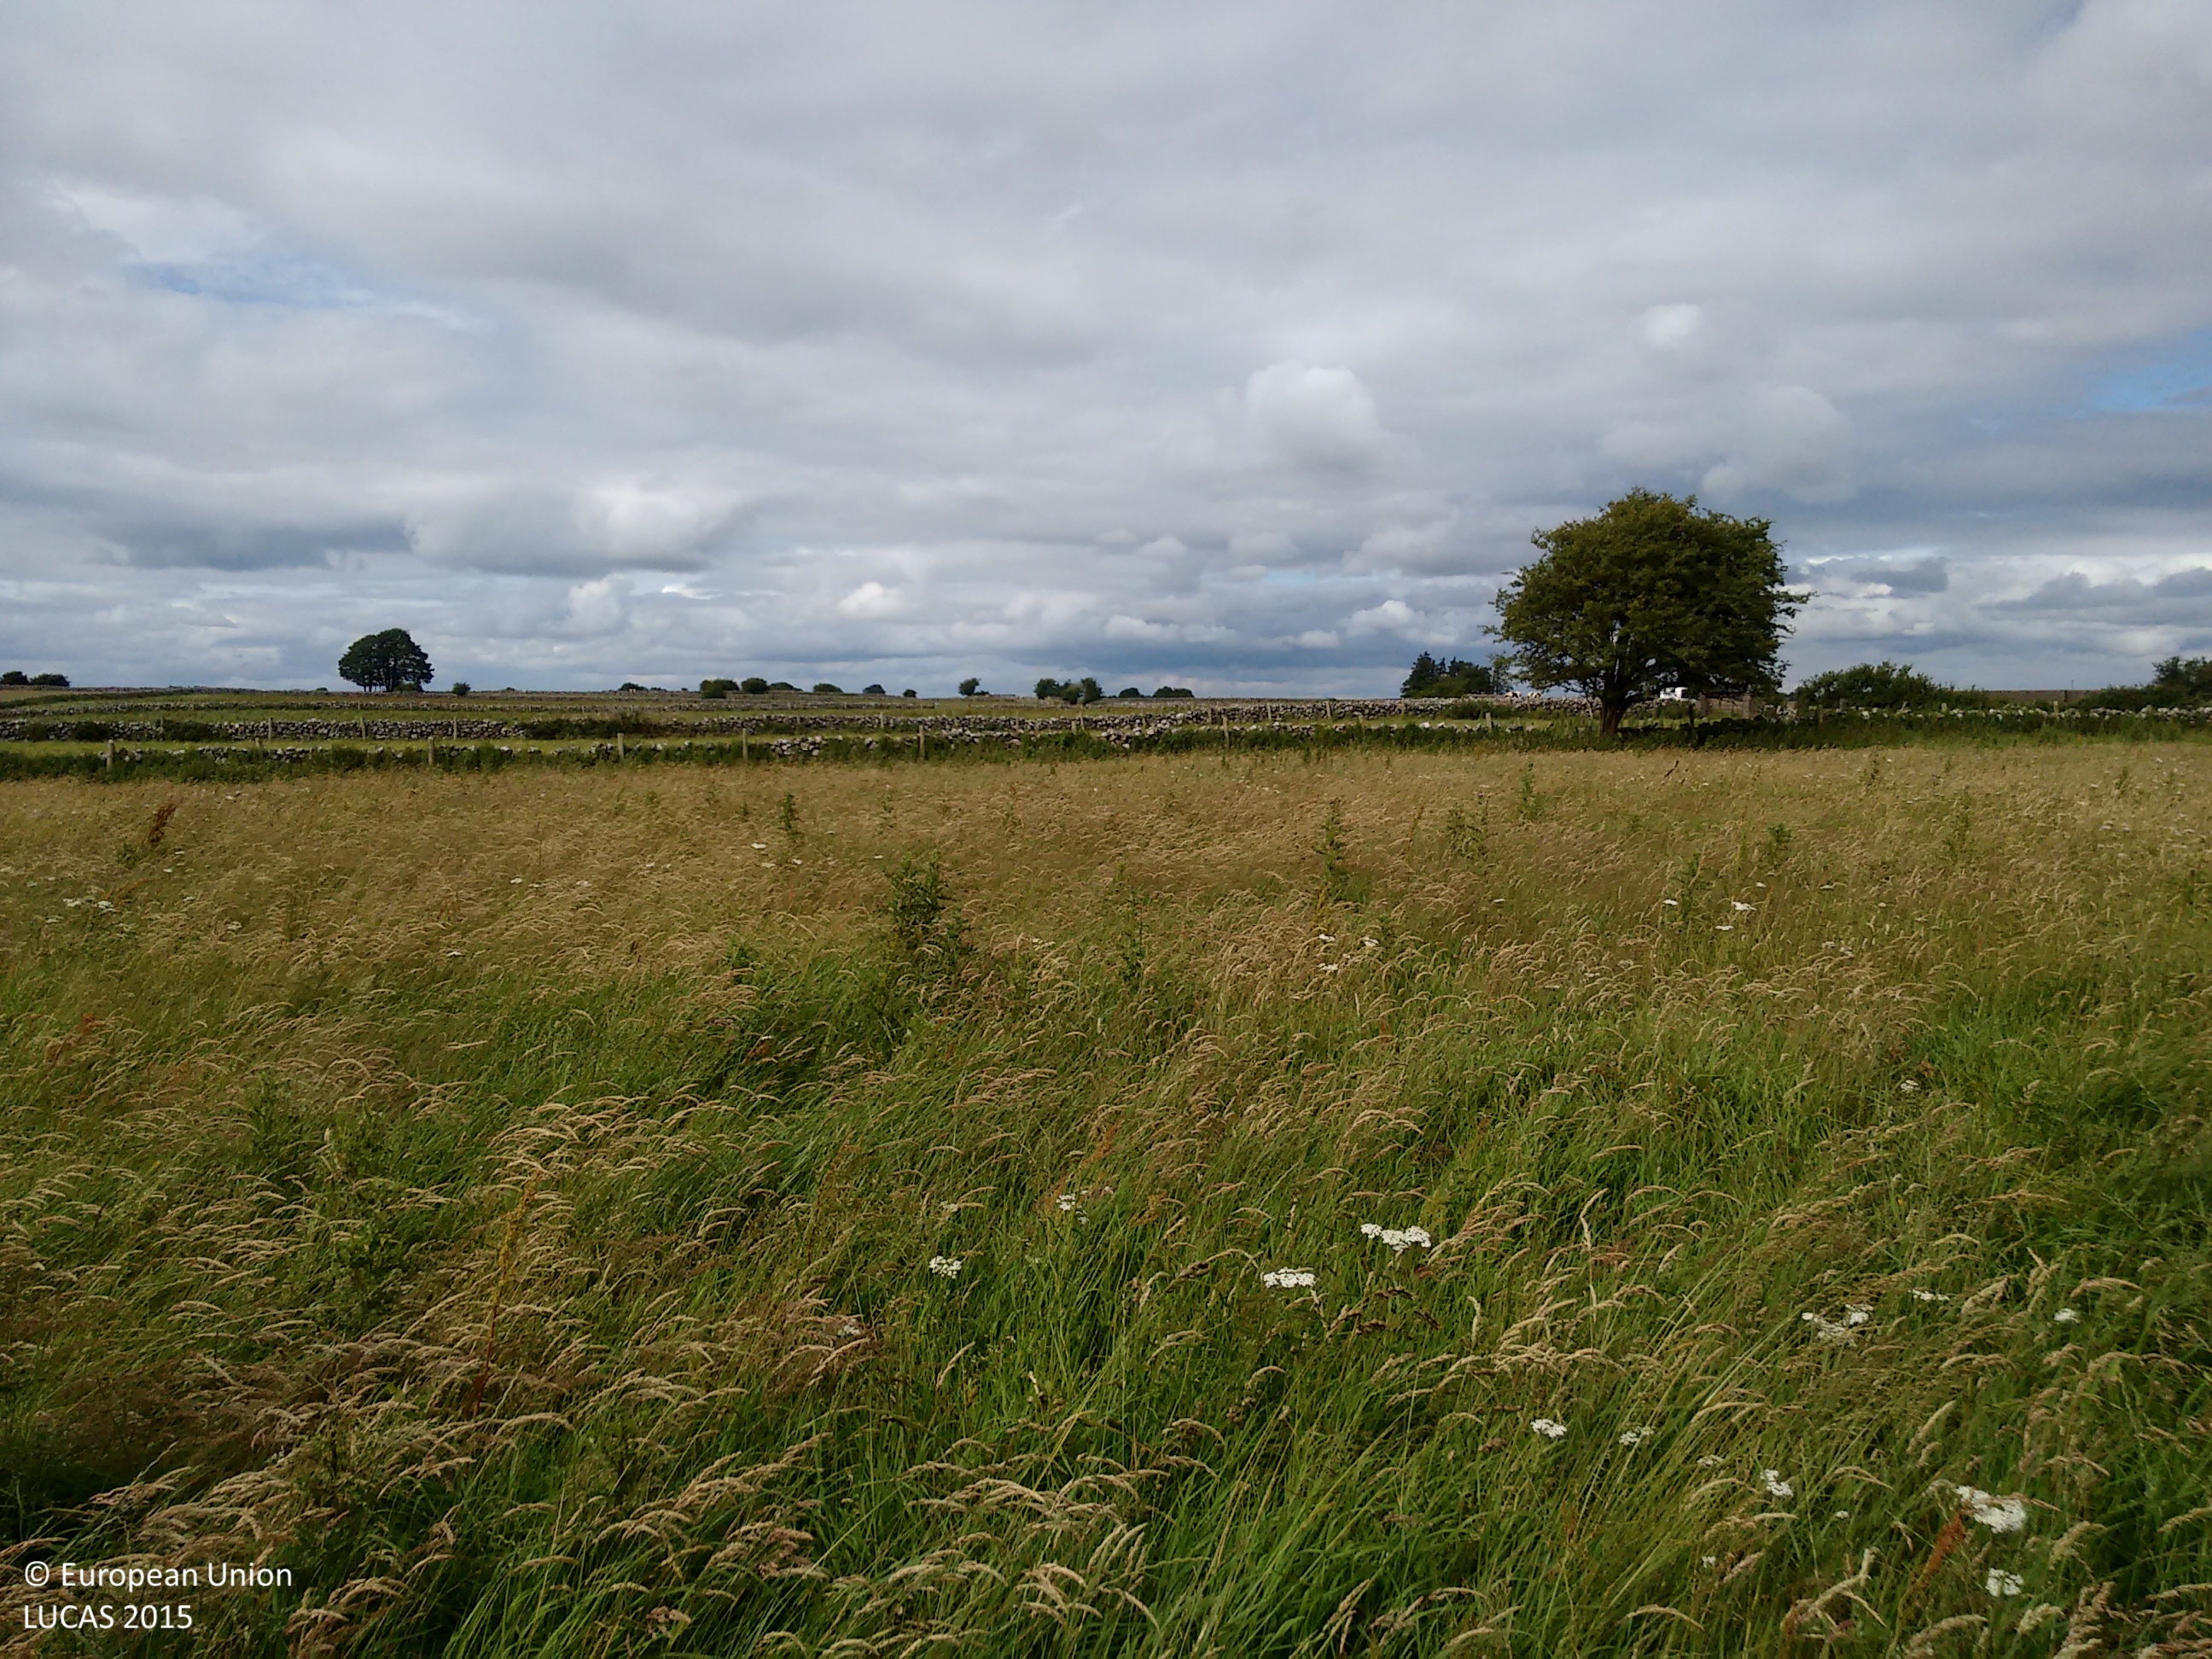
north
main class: Grassland
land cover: Grassland without tree/shrub cover
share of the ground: > 75 %
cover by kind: herbaceous plants 100 %
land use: Agriculture (excluding fallow land and kitchen gardens)
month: July
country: IE
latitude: 53.6146
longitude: -9.1277
